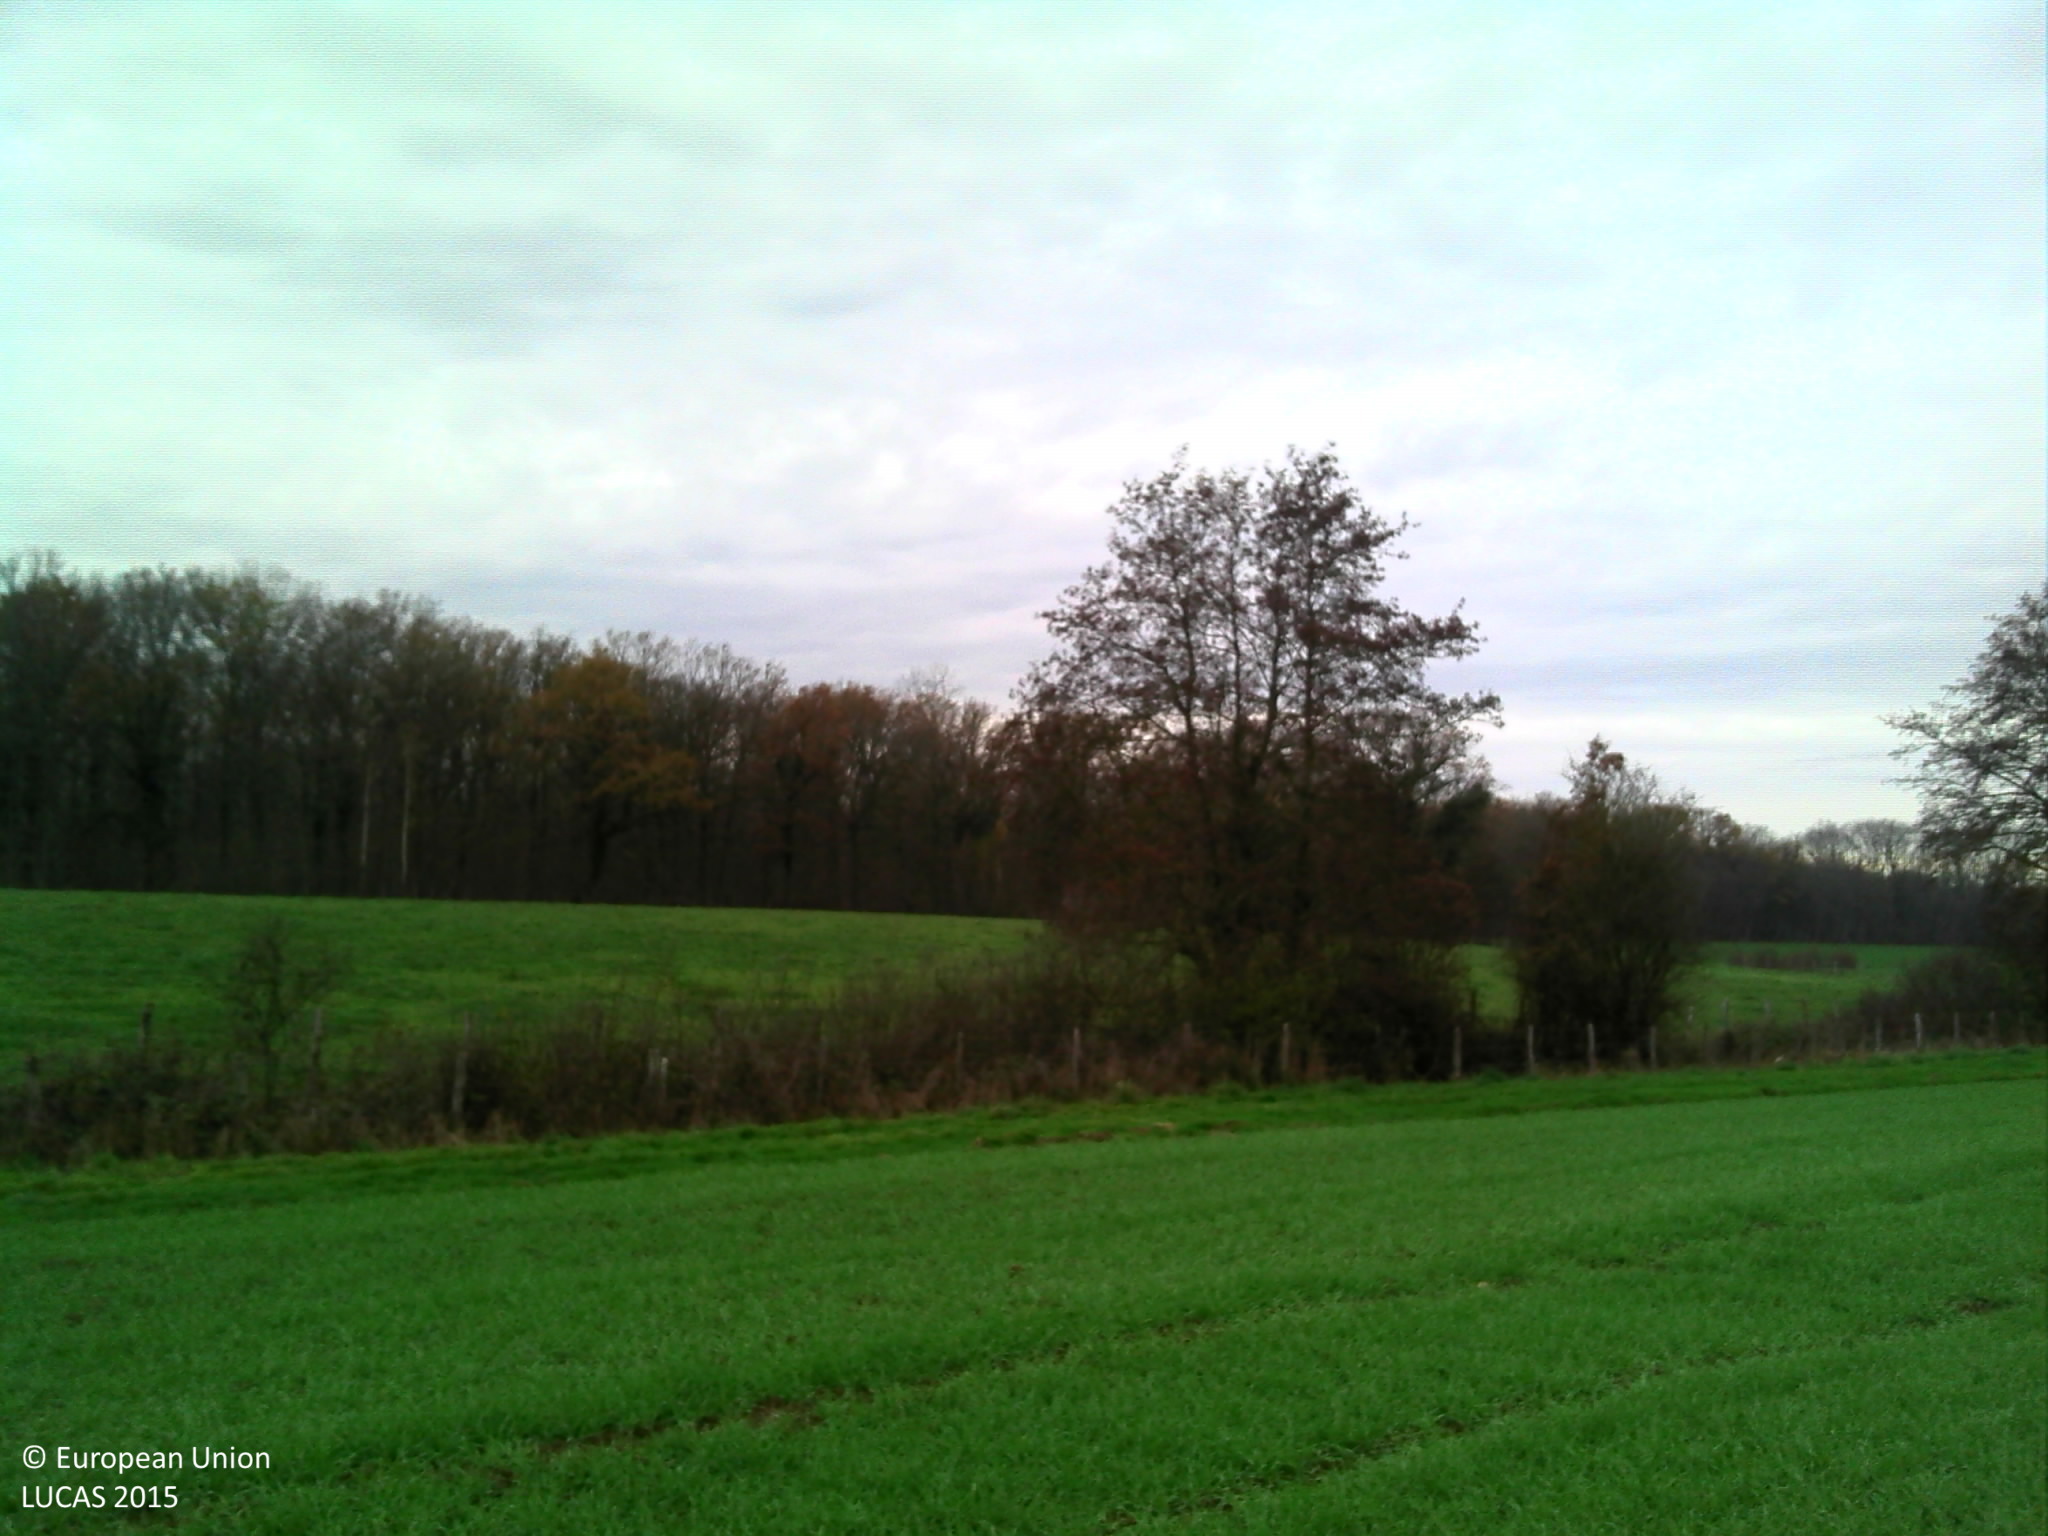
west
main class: Cropland
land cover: Common wheat
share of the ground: > 75 %
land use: Agriculture (excluding fallow land and kitchen gardens)
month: December
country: FR
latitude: 46.1329
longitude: 5.1493
